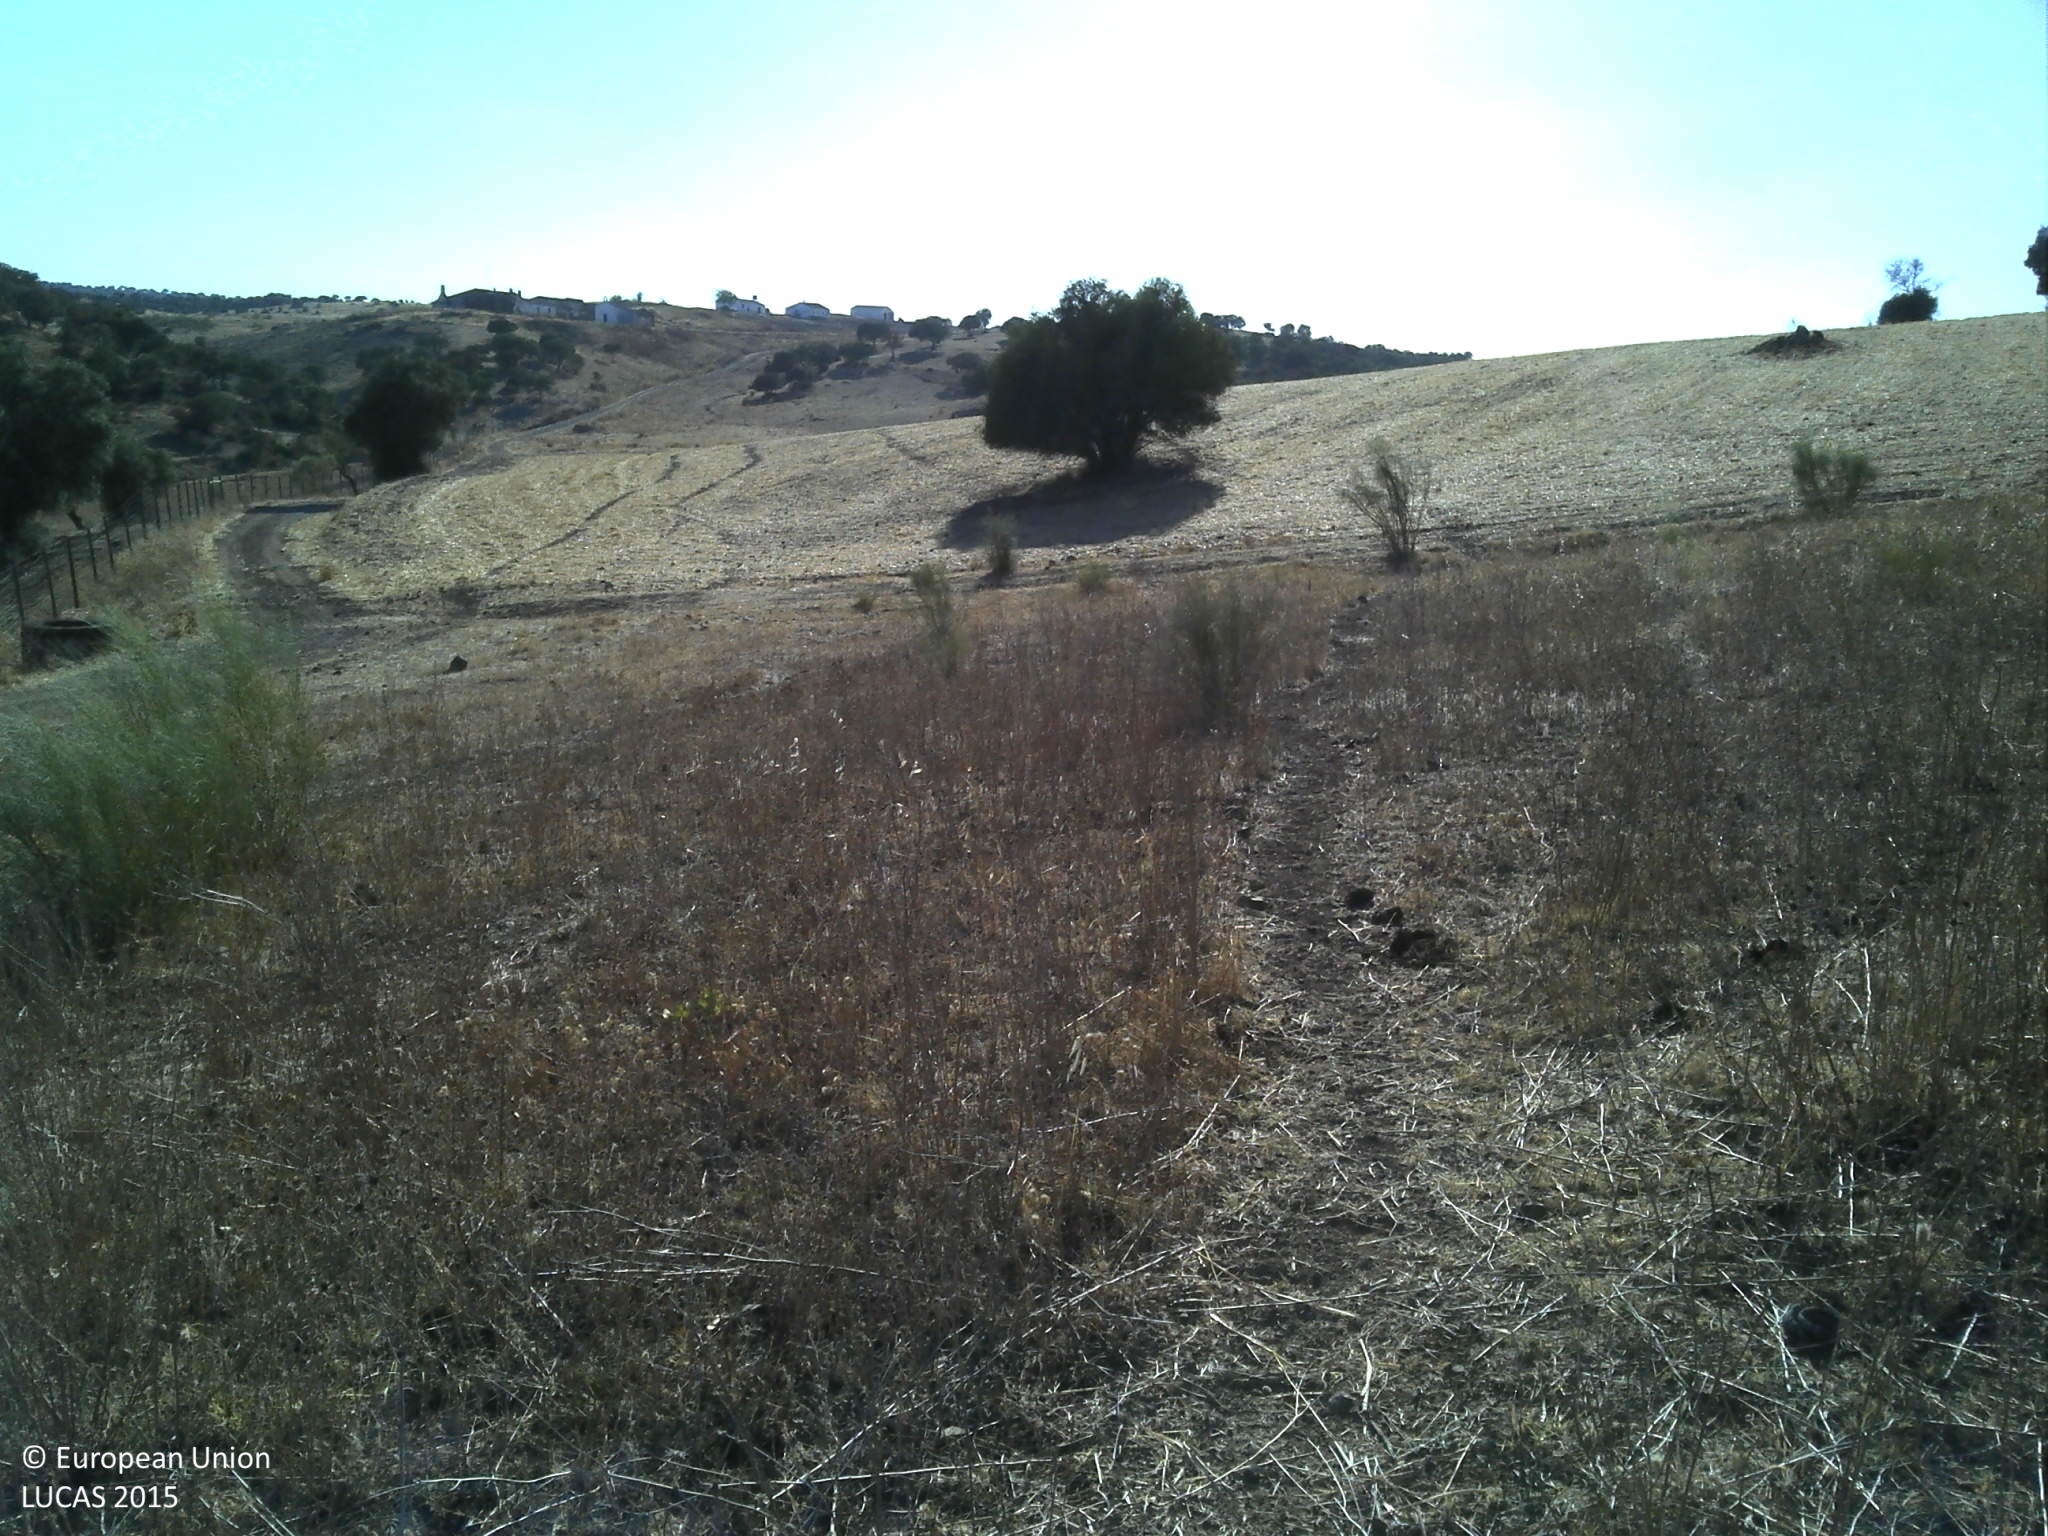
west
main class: Grassland
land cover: Grassland with sparse tree/shrub cover
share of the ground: 25 - 50 %
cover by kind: herbaceous plants 90 %, broadleaved forest trees 5 %, unconsolidated bare surface 5 %
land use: Agriculture (excluding fallow land and kitchen gardens)
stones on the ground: < 10 %
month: July
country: PT
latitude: 37.9113
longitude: -7.6625
